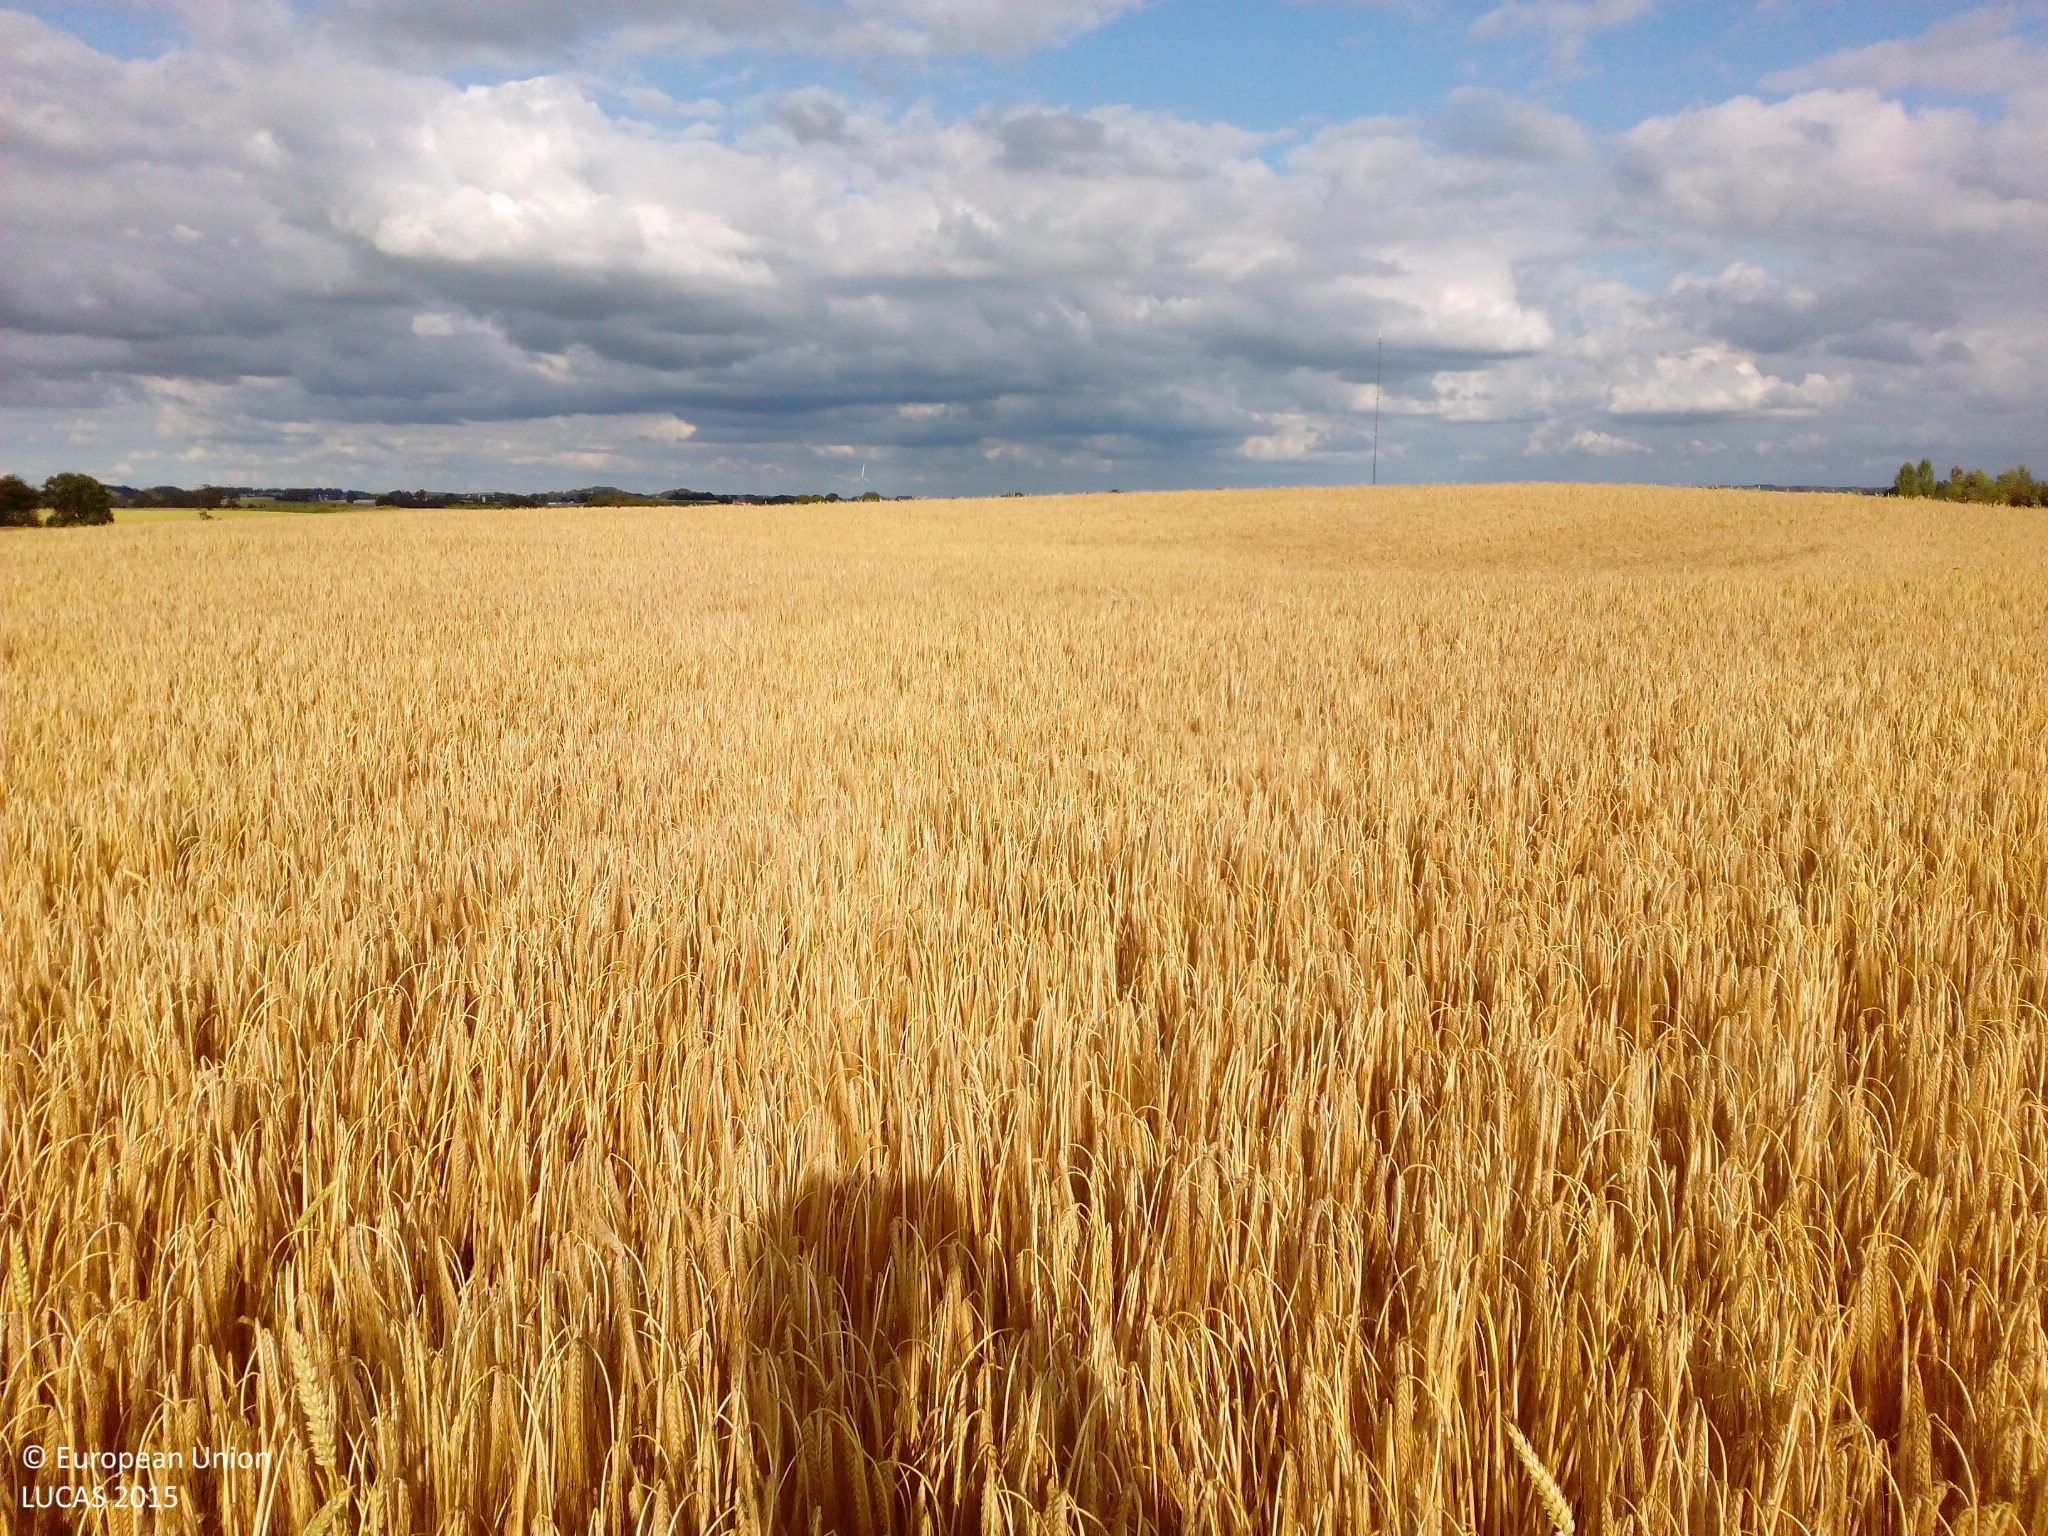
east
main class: Cropland
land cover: Barley
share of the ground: > 75 %
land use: Agriculture (excluding fallow land and kitchen gardens)
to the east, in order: Barley; Grass margins; Paved roads, cycling and walking lanes; Grass margins; Rape and turnip rape
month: July
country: DK
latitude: 55.6945
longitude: 11.4146
